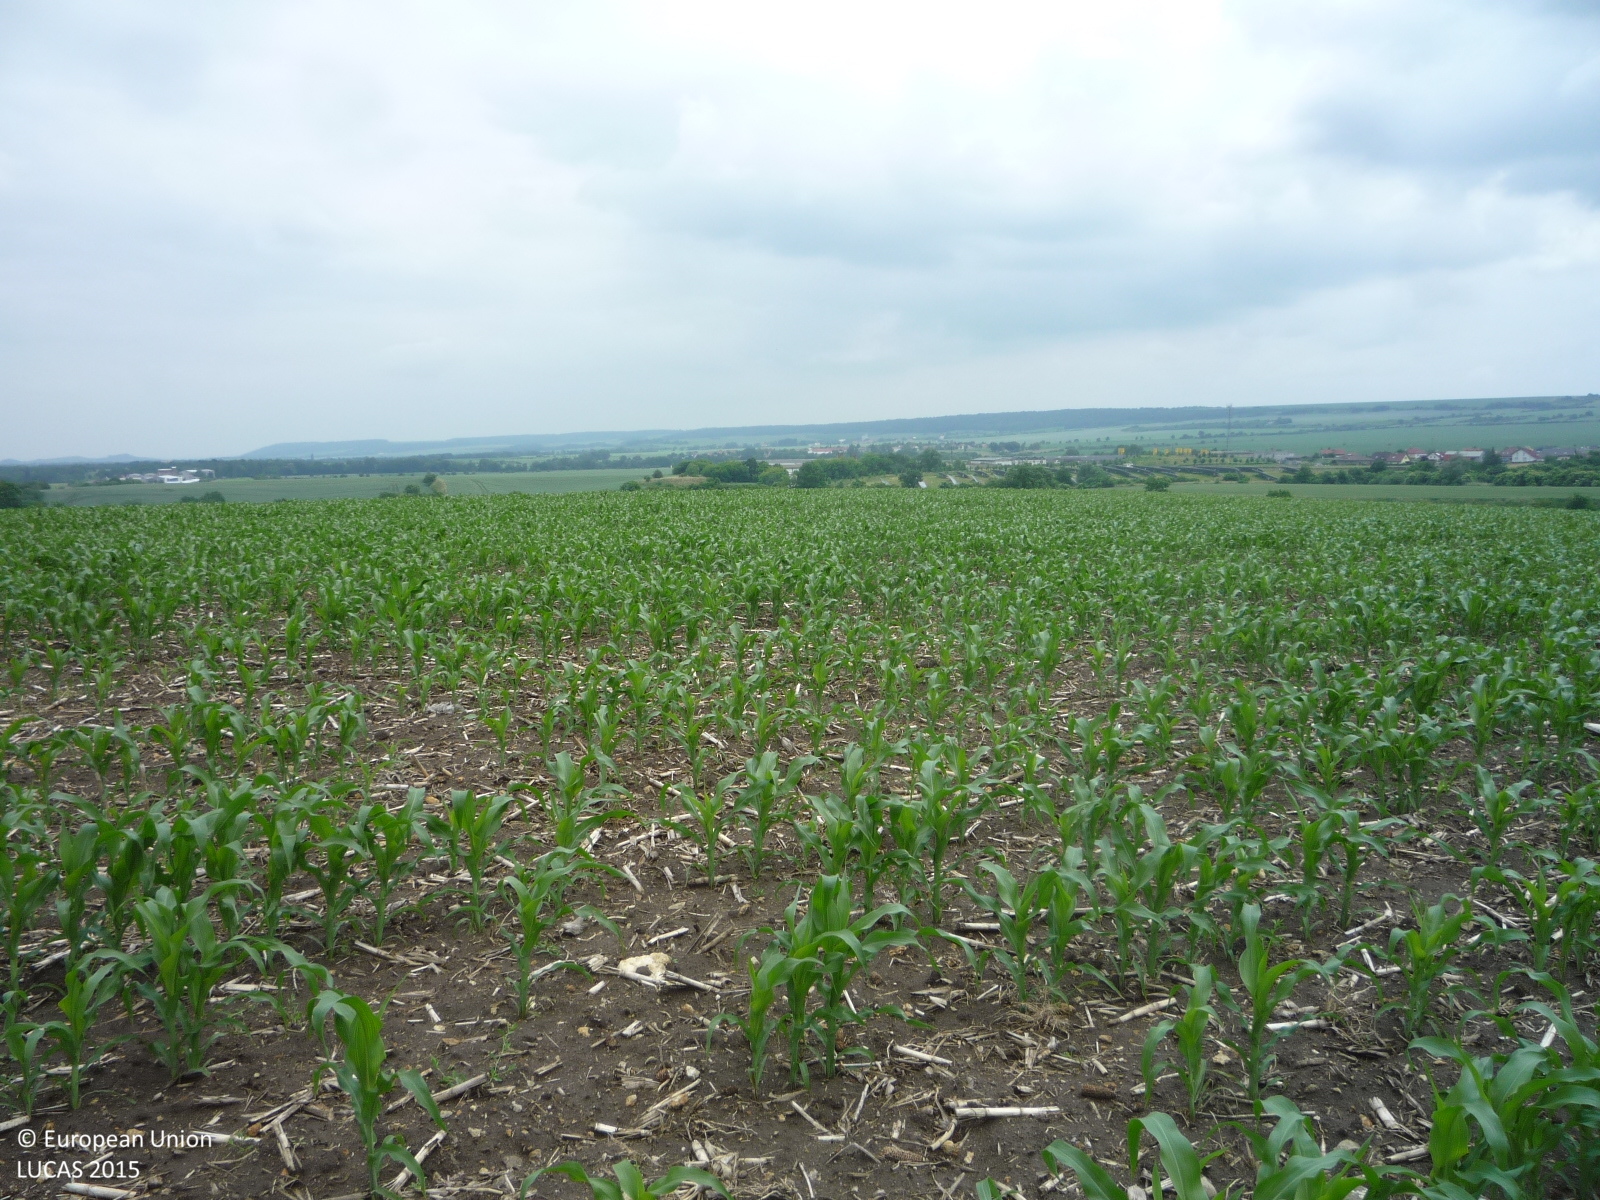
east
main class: Cropland
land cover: Maize
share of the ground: 25 - 50 %
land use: Agriculture (excluding fallow land and kitchen gardens)
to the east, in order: Maize
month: June
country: CZ
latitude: 50.3537
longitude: 13.8377
